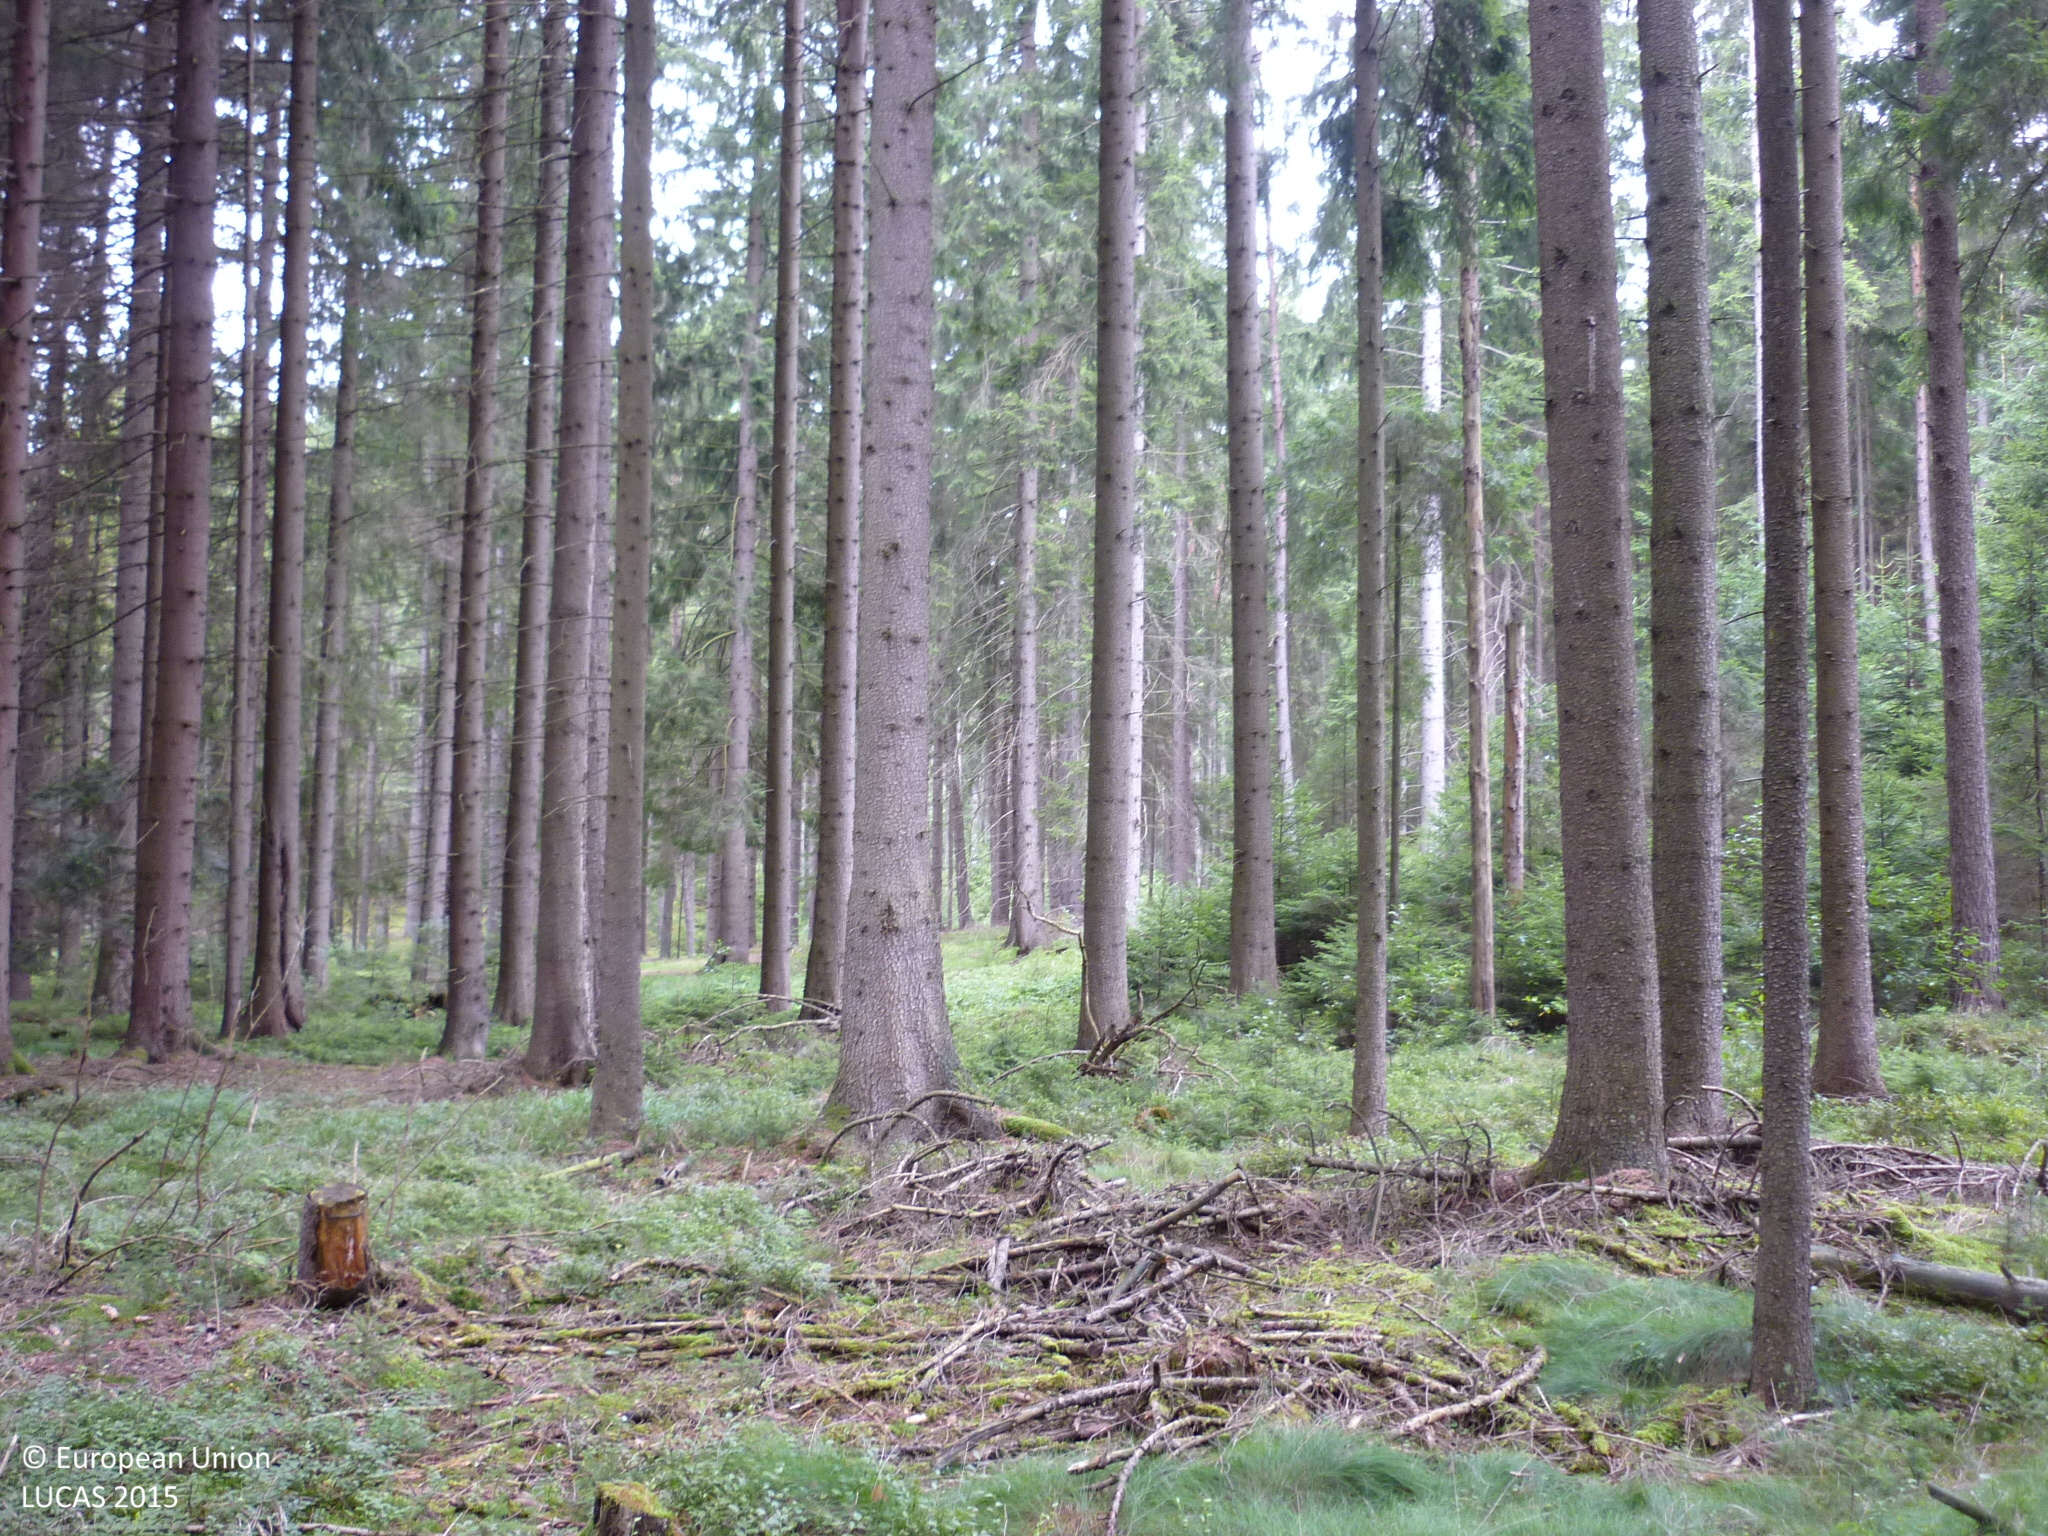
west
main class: Woodland
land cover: Spruce dominated coniferous woodland
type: hemiboreal forest and nemoral coniferous forest and mixed broadleaved-coniferous forest
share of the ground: > 75 %
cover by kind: coniferous forest trees 95 %, lichens and mosses 5 %
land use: Forestry
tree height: > 5 m
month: September
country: AT
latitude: 48.8262
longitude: 15.1102
